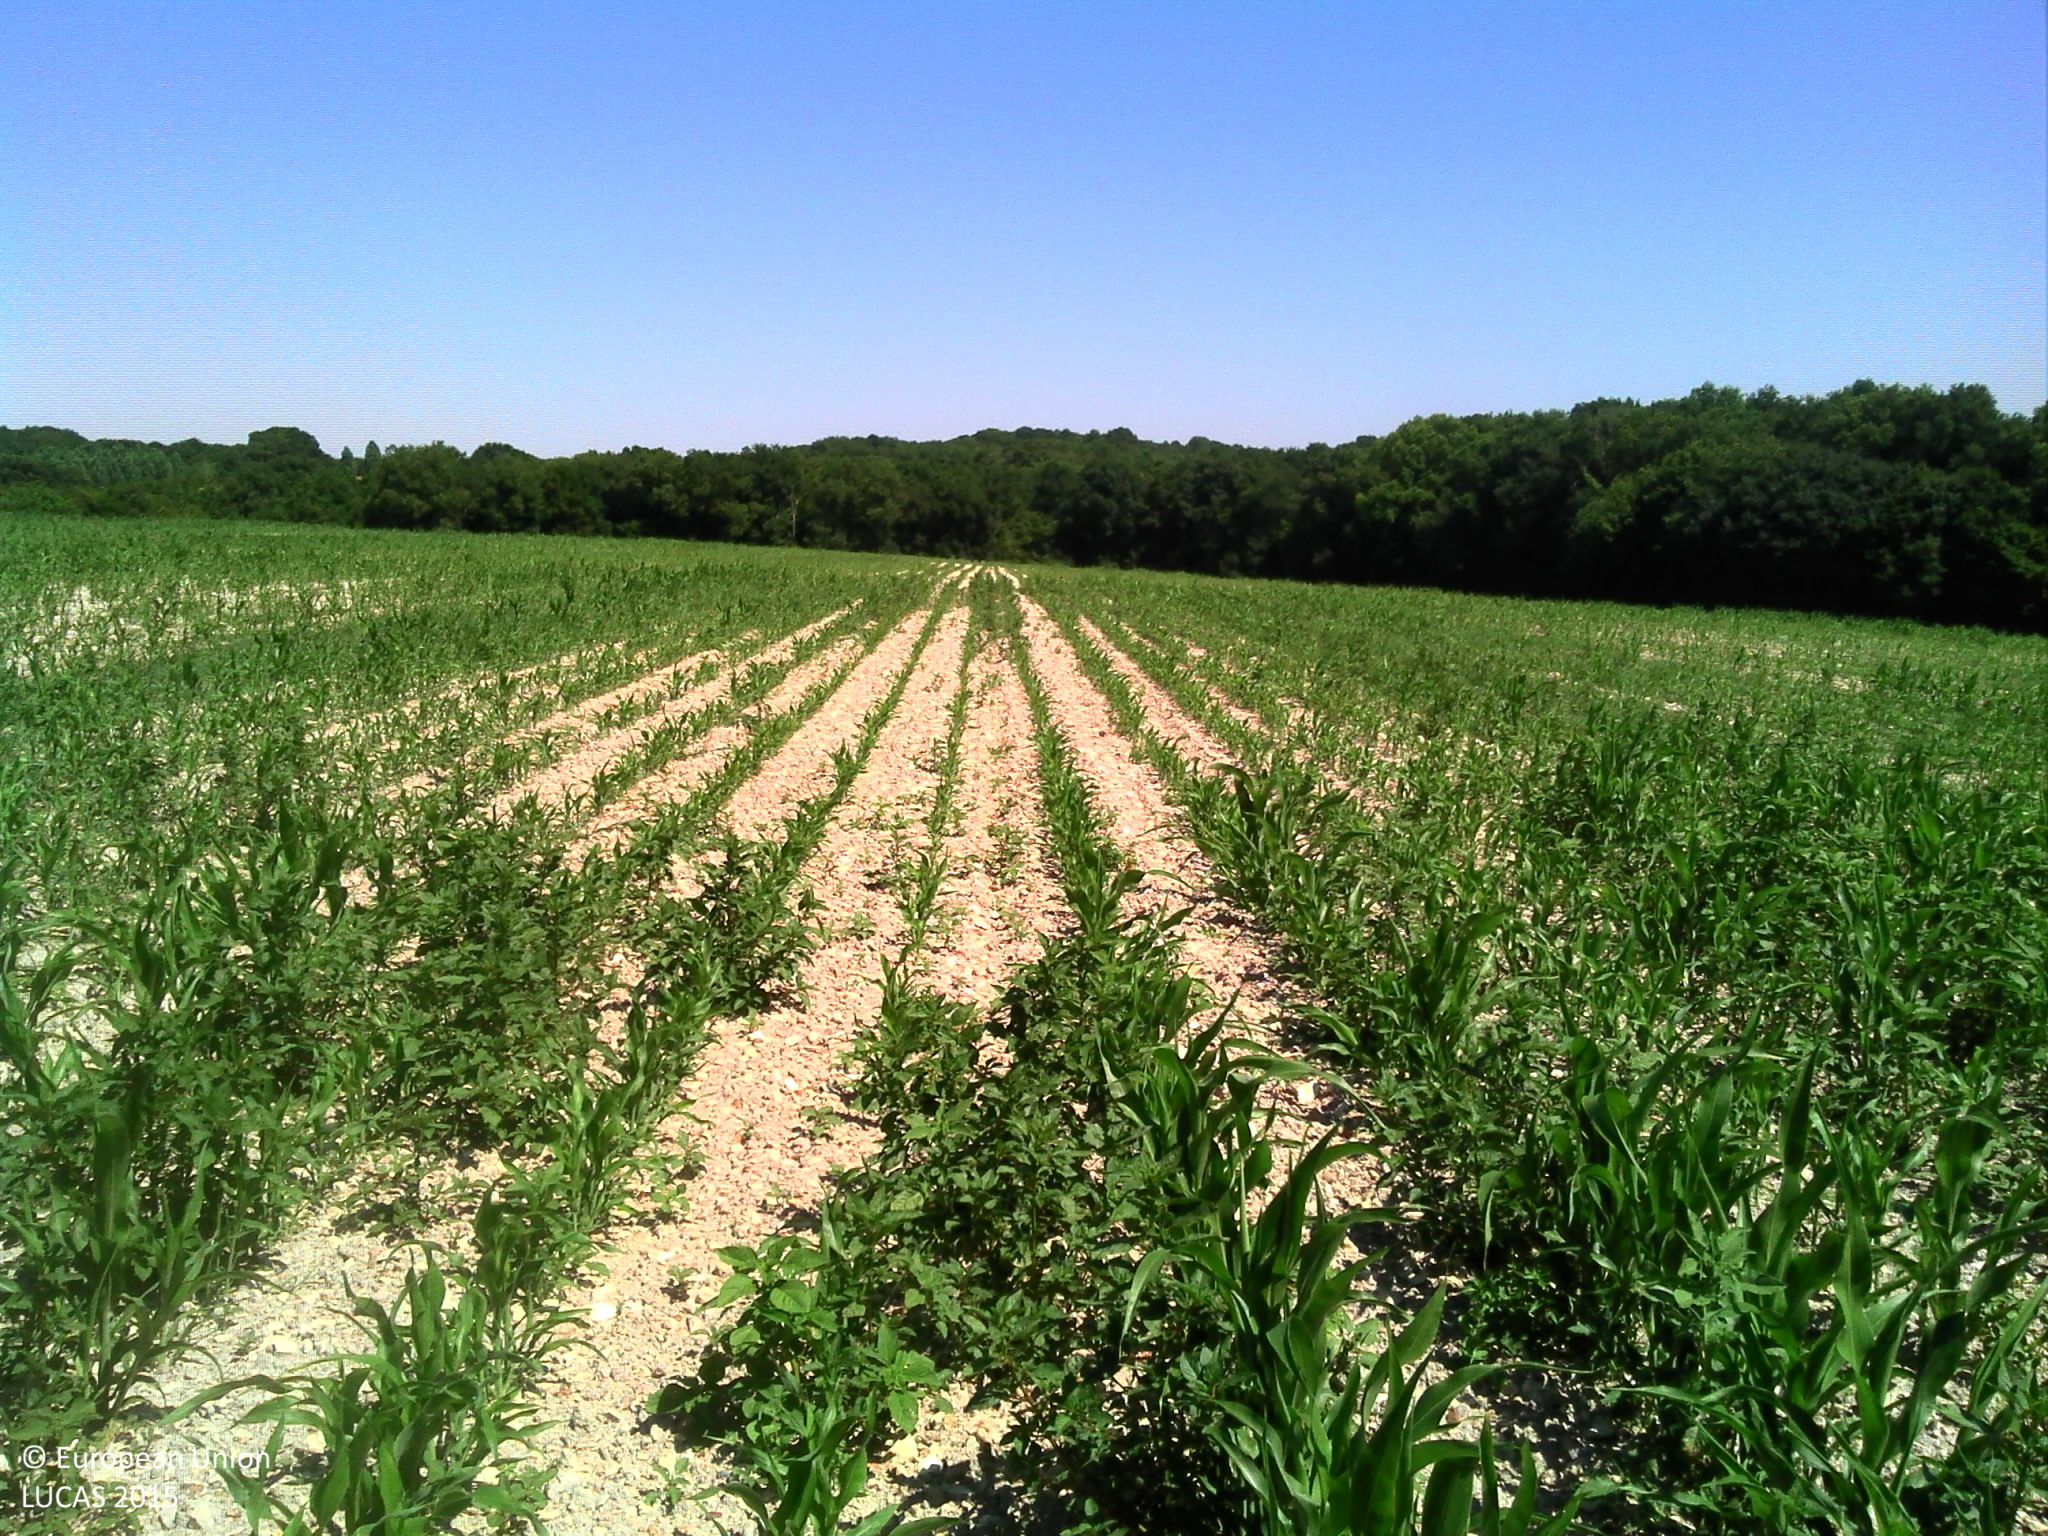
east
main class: Cropland
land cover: Maize
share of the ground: 25 - 50 %
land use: Agriculture (excluding fallow land and kitchen gardens)
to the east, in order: Maize
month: July
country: FR
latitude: 47.2357
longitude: 0.5353
